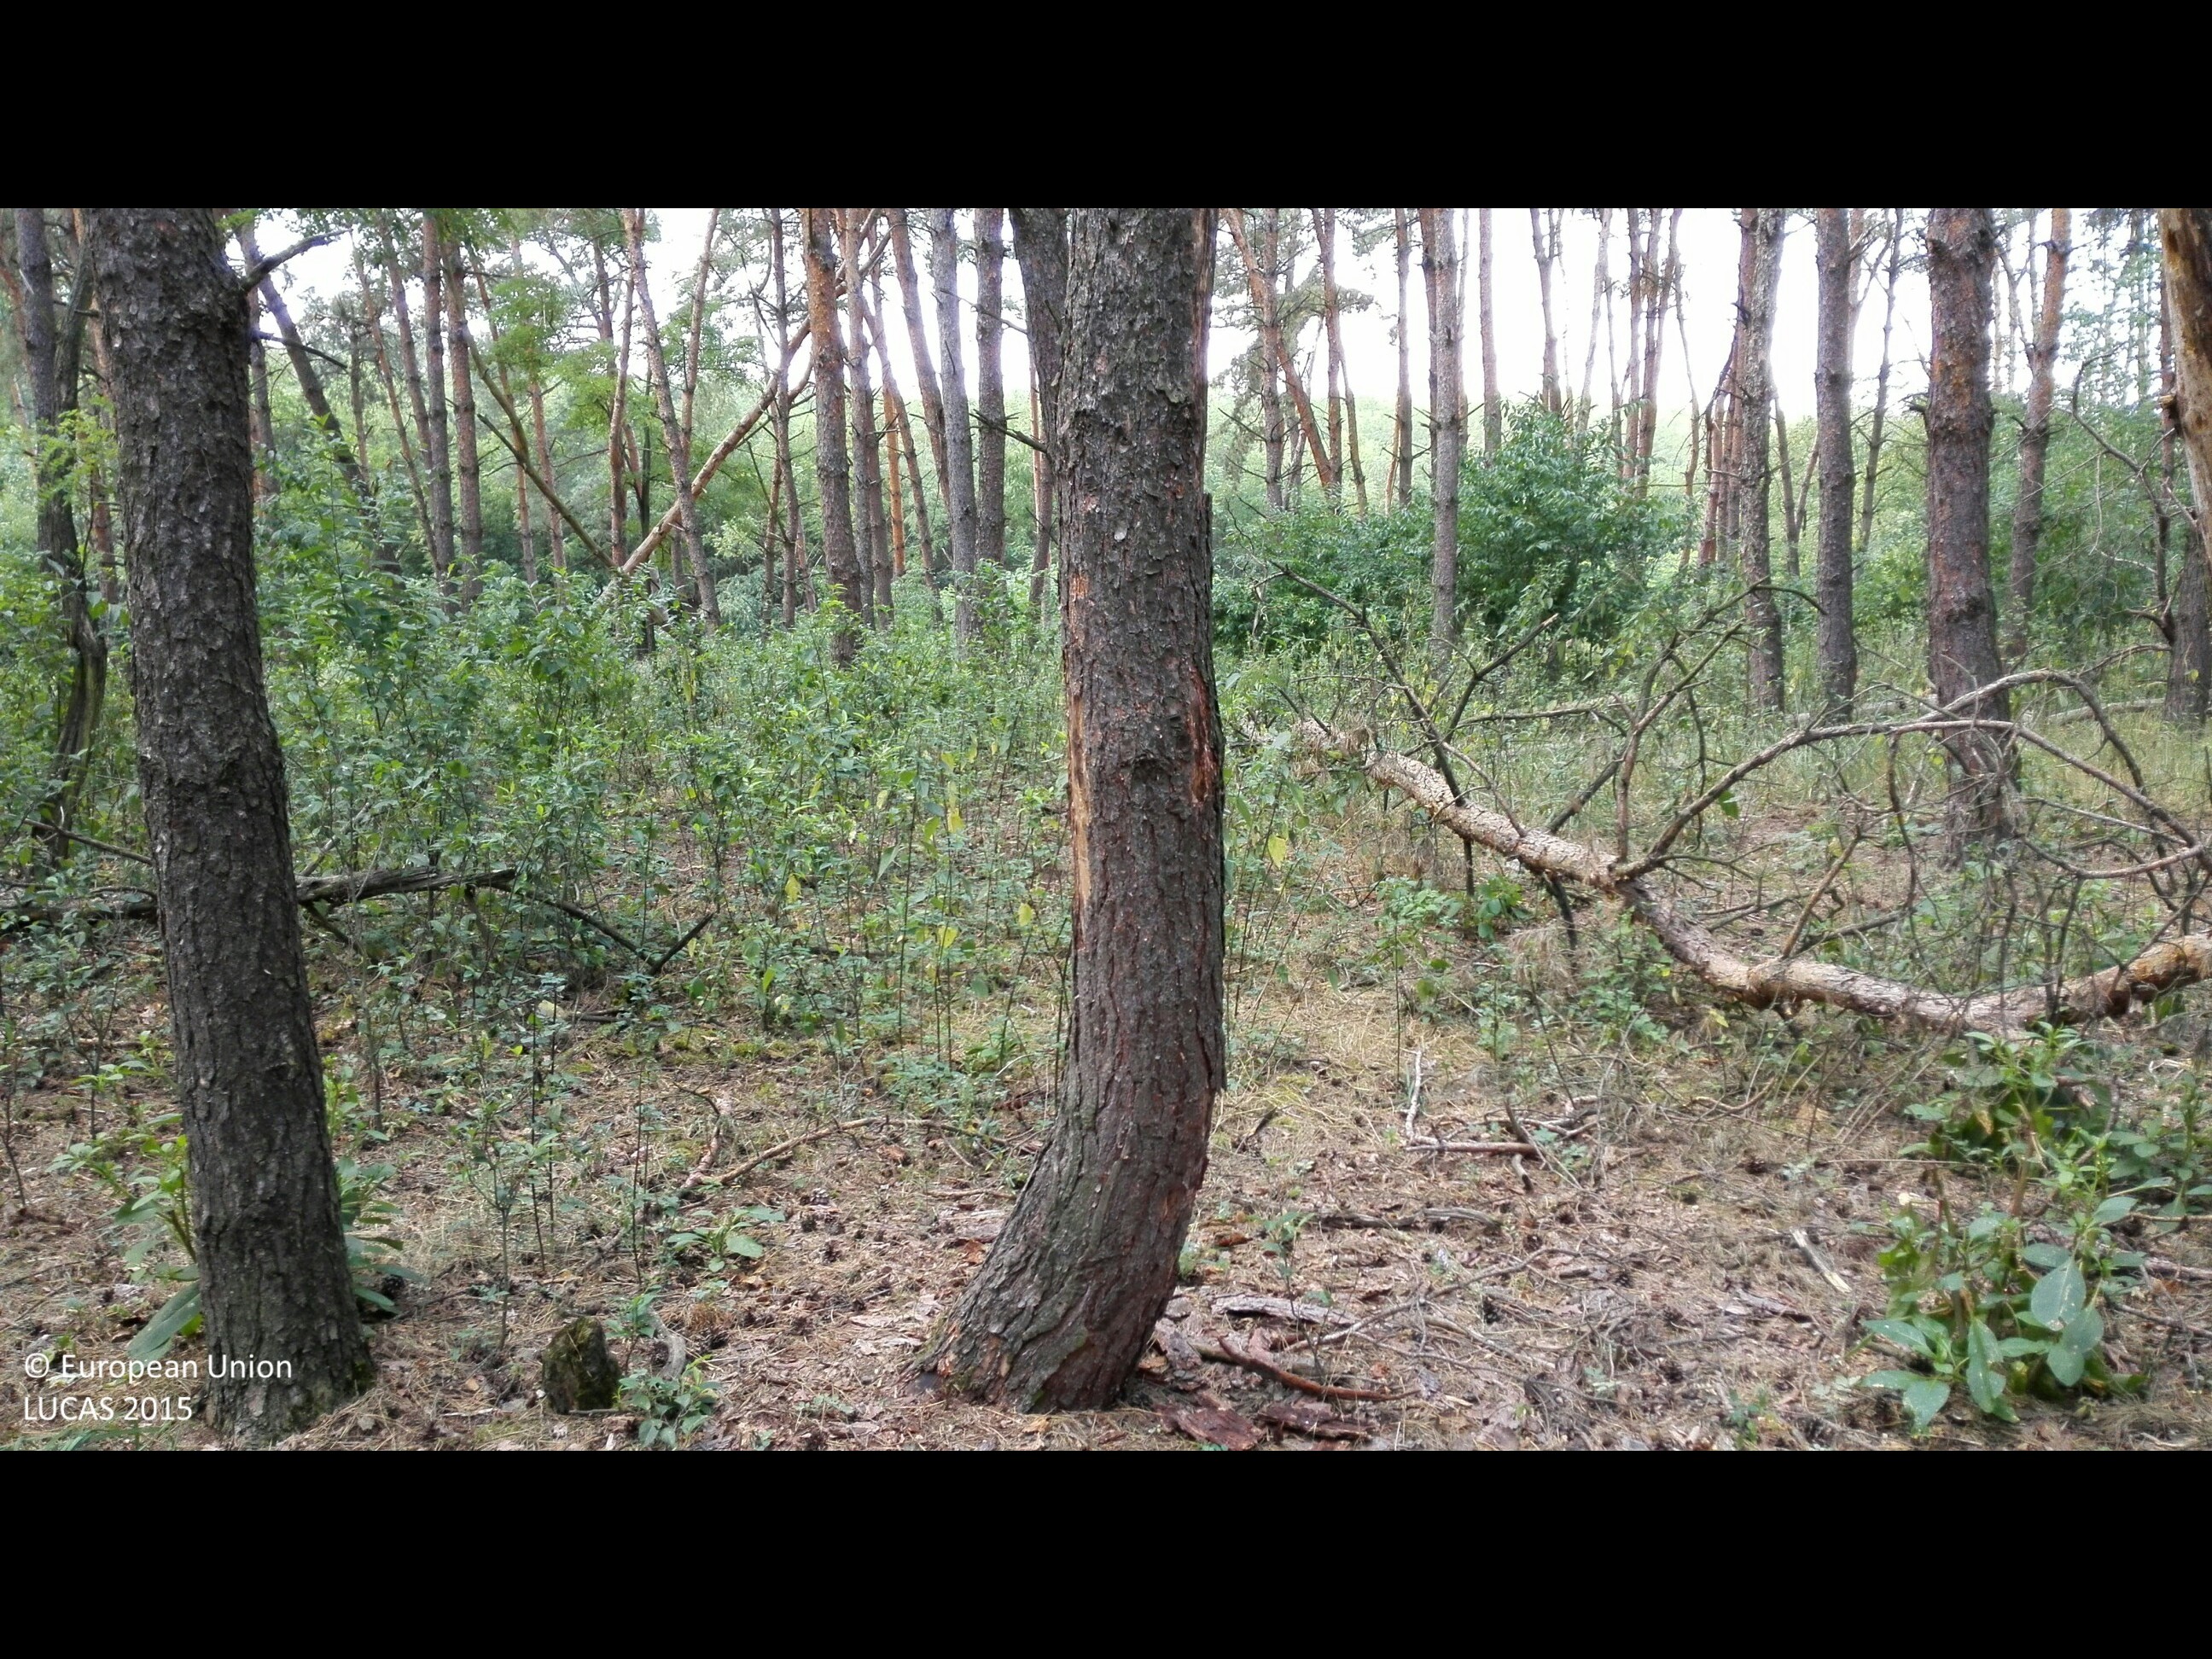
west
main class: Woodland
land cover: Pine dominated coniferous woodland
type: hemiboreal forest and nemoral coniferous forest and mixed broadleaved-coniferous forest
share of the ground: > 75 %
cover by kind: coniferous forest trees 95 %, broadleaved forest trees 5 %
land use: Forestry
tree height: > 5 m
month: August
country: HU
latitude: 47.6302
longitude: 21.9064
